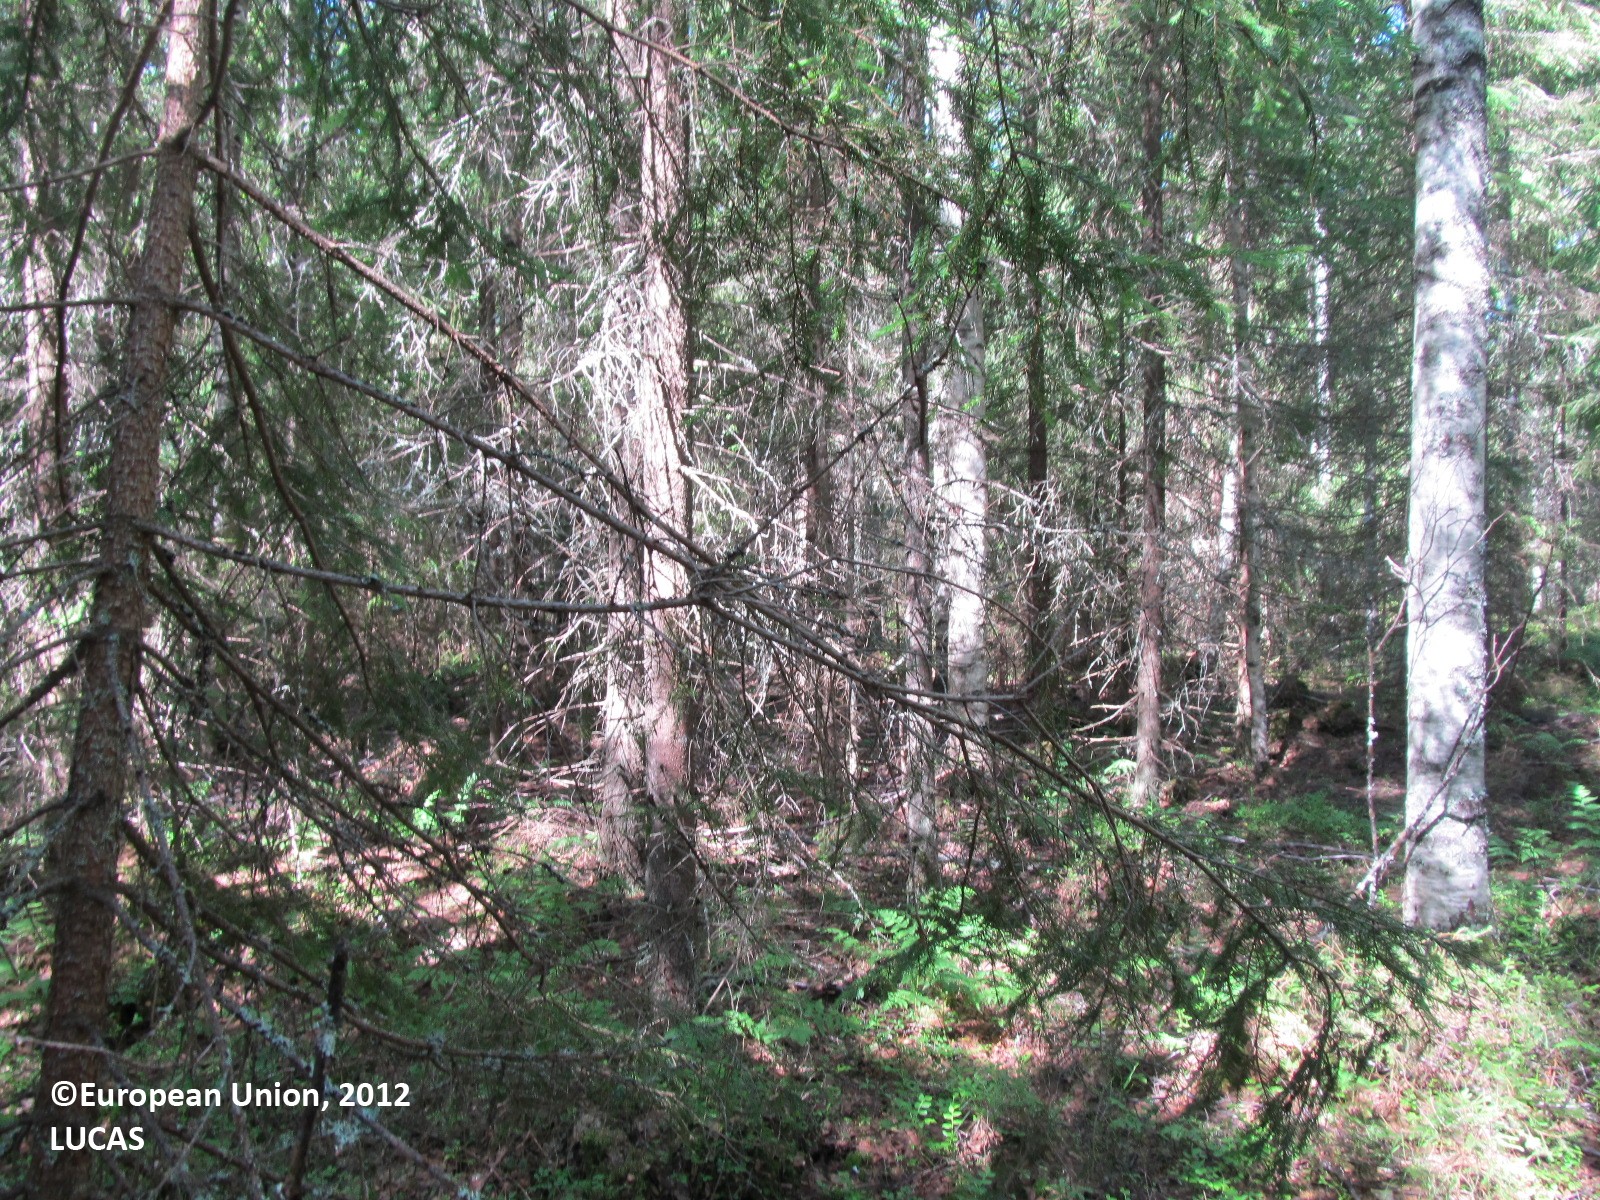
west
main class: Woodland
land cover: Spruce dominated mixed woodland
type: boreal forest
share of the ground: 50 - 75 %
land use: Forestry
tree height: > 5 m
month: July
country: FI
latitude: 62.4672
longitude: 29.1317
